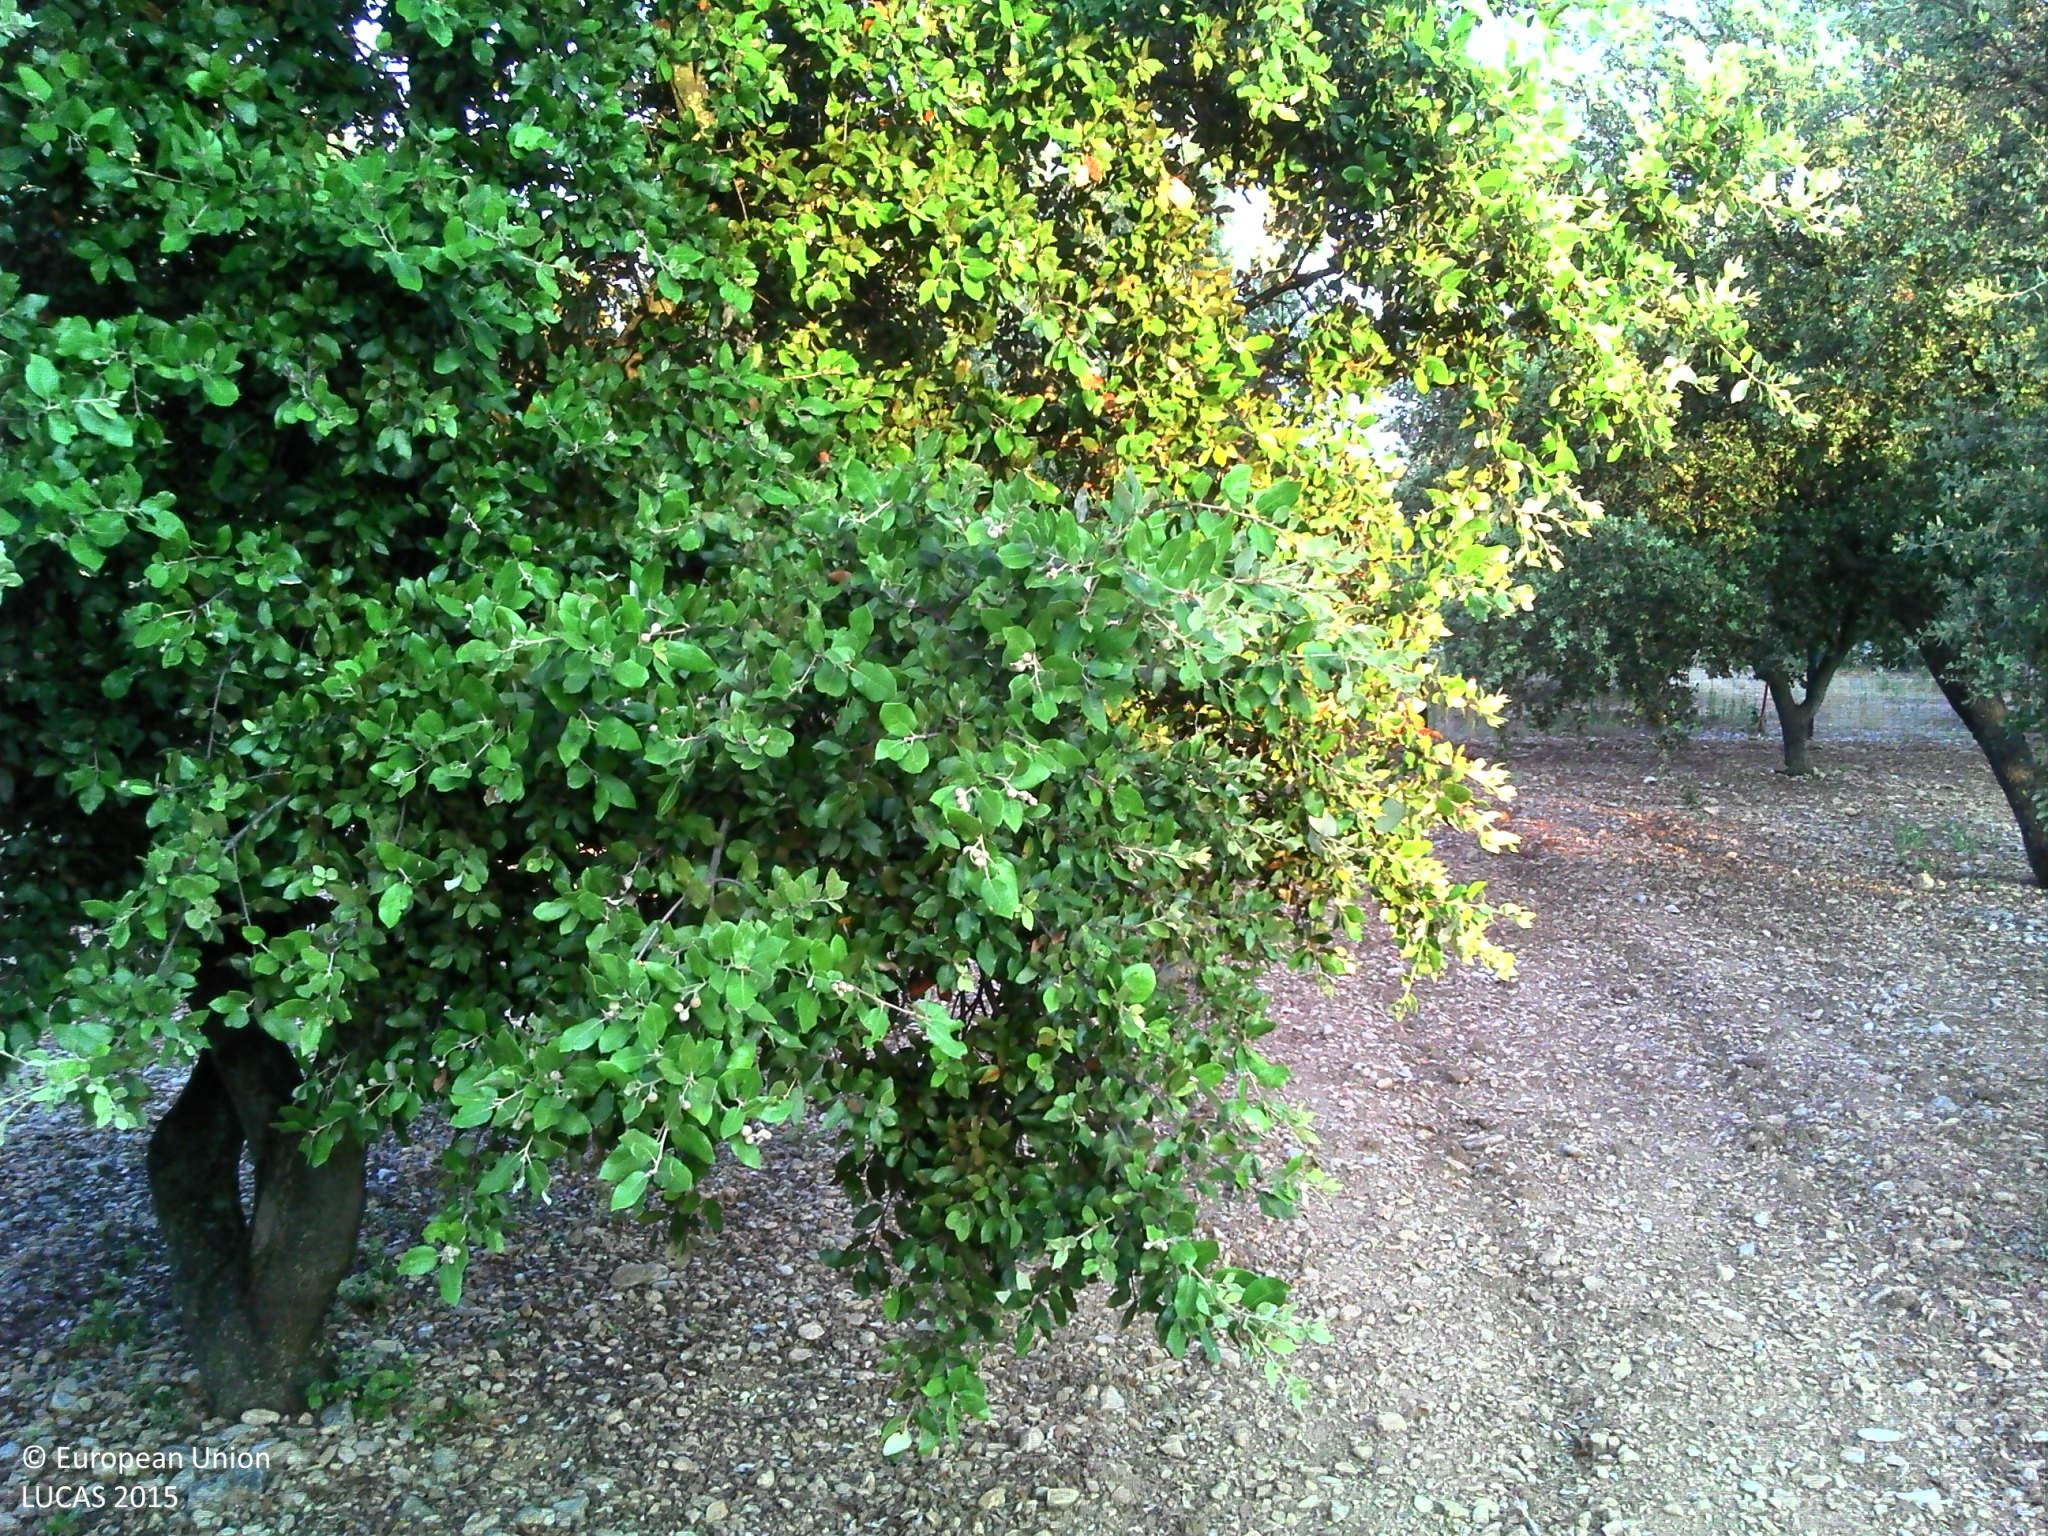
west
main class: Cropland
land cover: Pear fruit
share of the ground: 25 - 50 %
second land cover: Other bare soil
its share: > 75 %
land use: Agriculture (excluding fallow land and kitchen gardens)
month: July
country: FR
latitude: 44.0159
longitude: 5.0561
